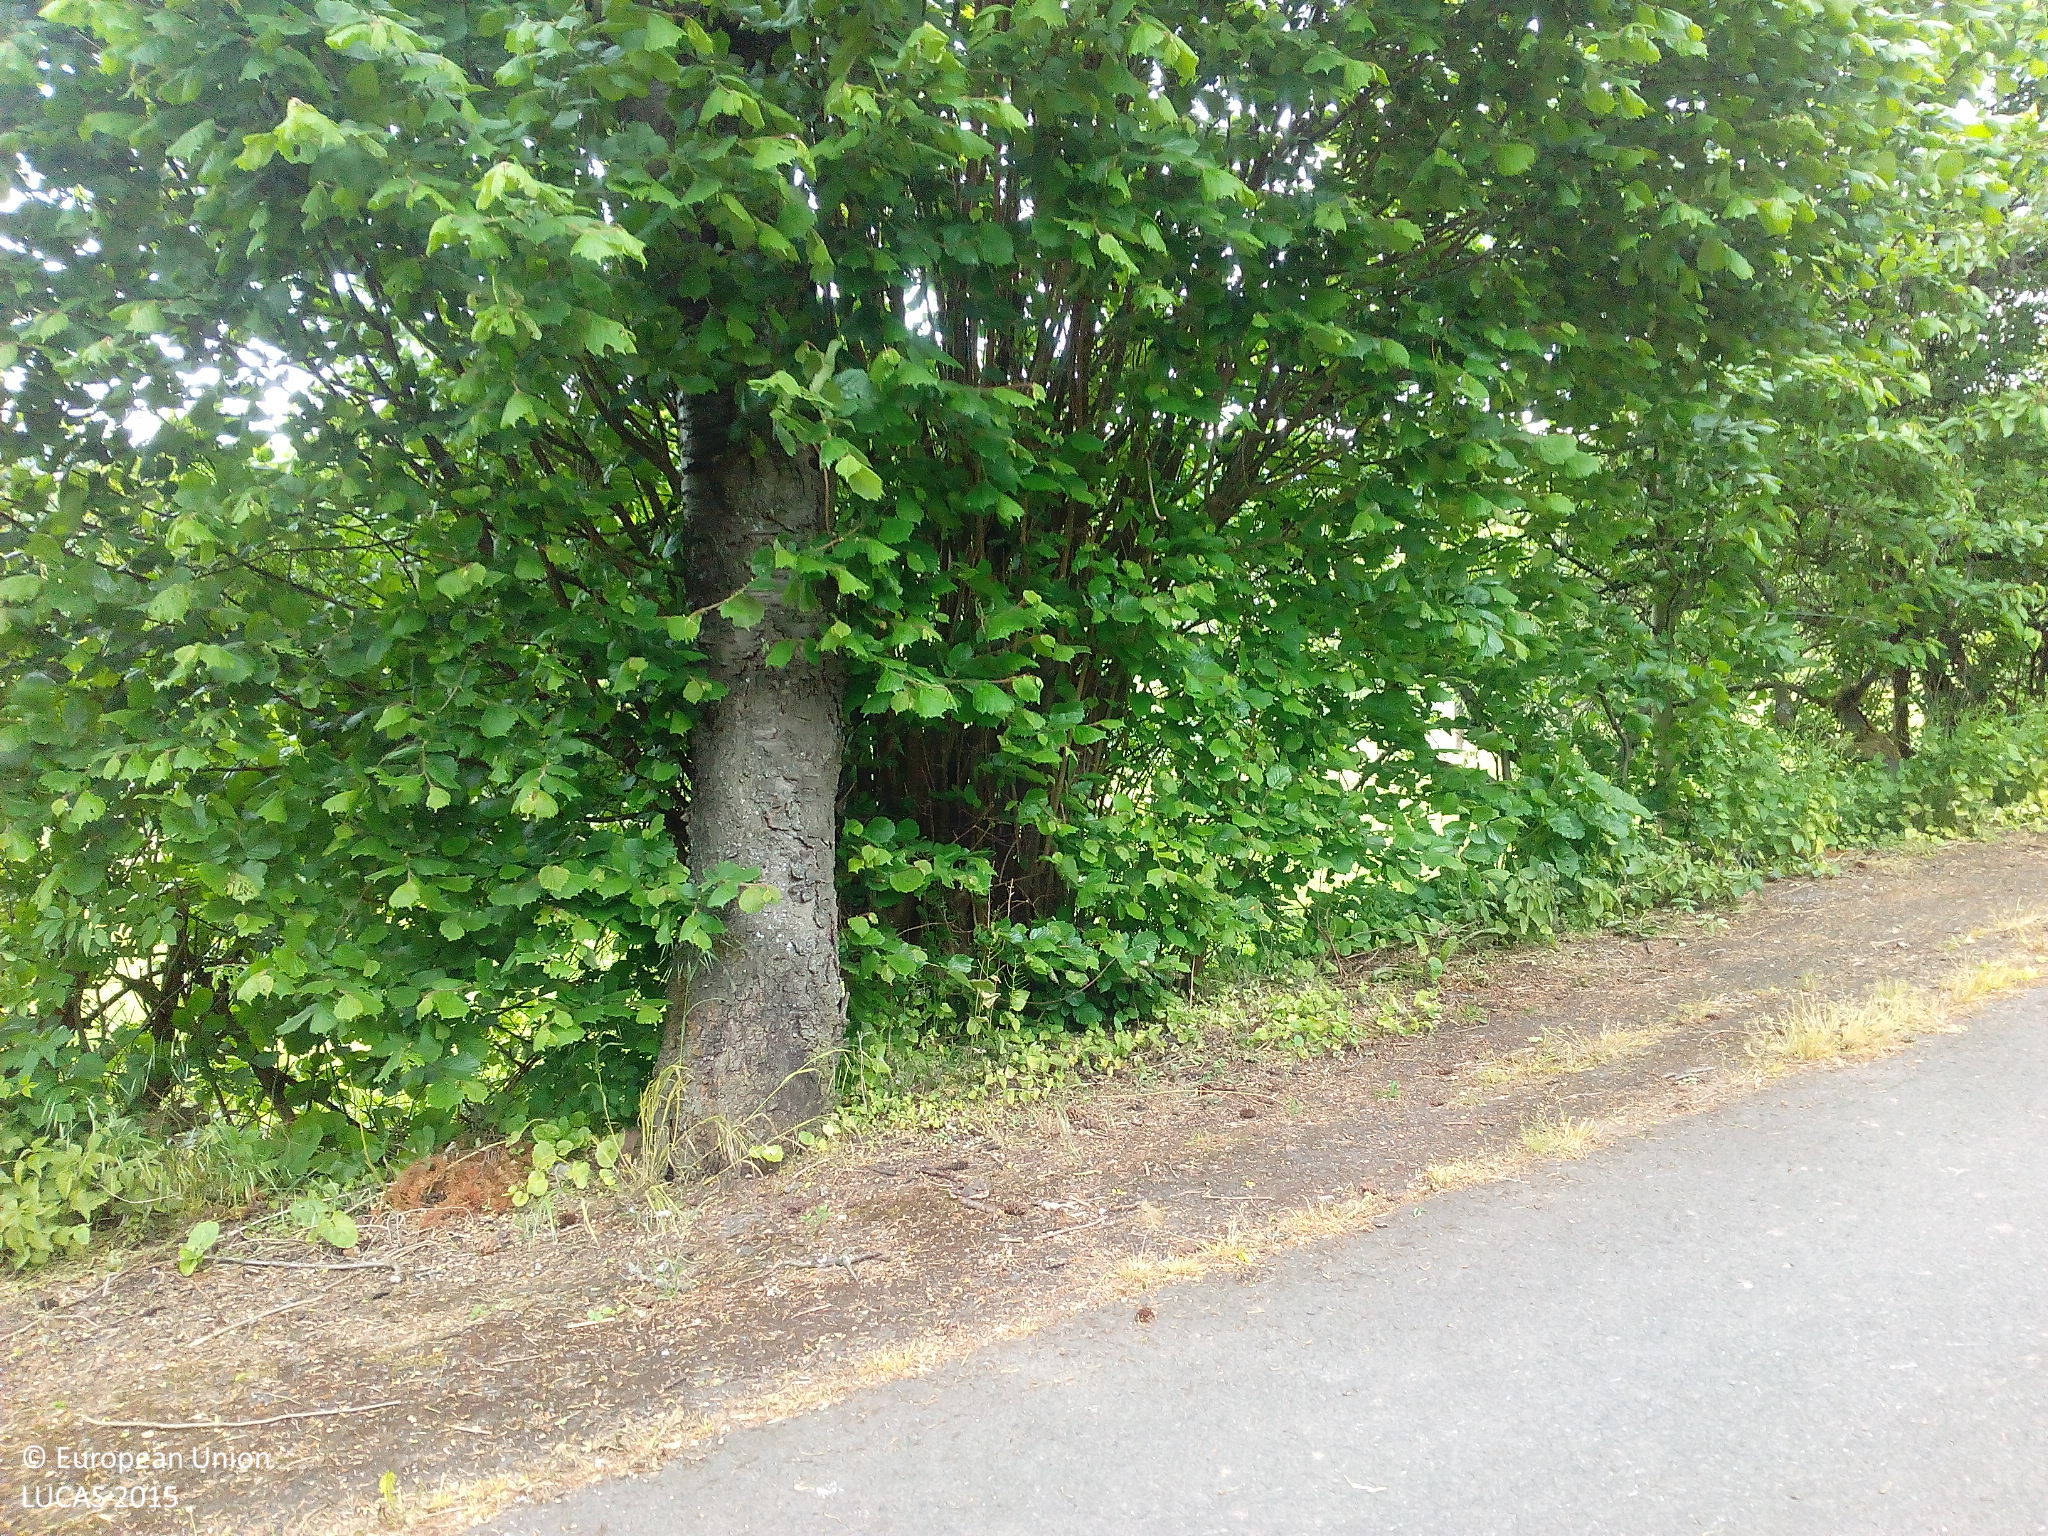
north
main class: Cropland
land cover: Cherry fruit
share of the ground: 10 - 25 %
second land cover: Grassland without tree/shrub cover
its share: > 75 %
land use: Agriculture (excluding fallow land and kitchen gardens)
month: May
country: DE
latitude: 51.2988
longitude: 9.8423
